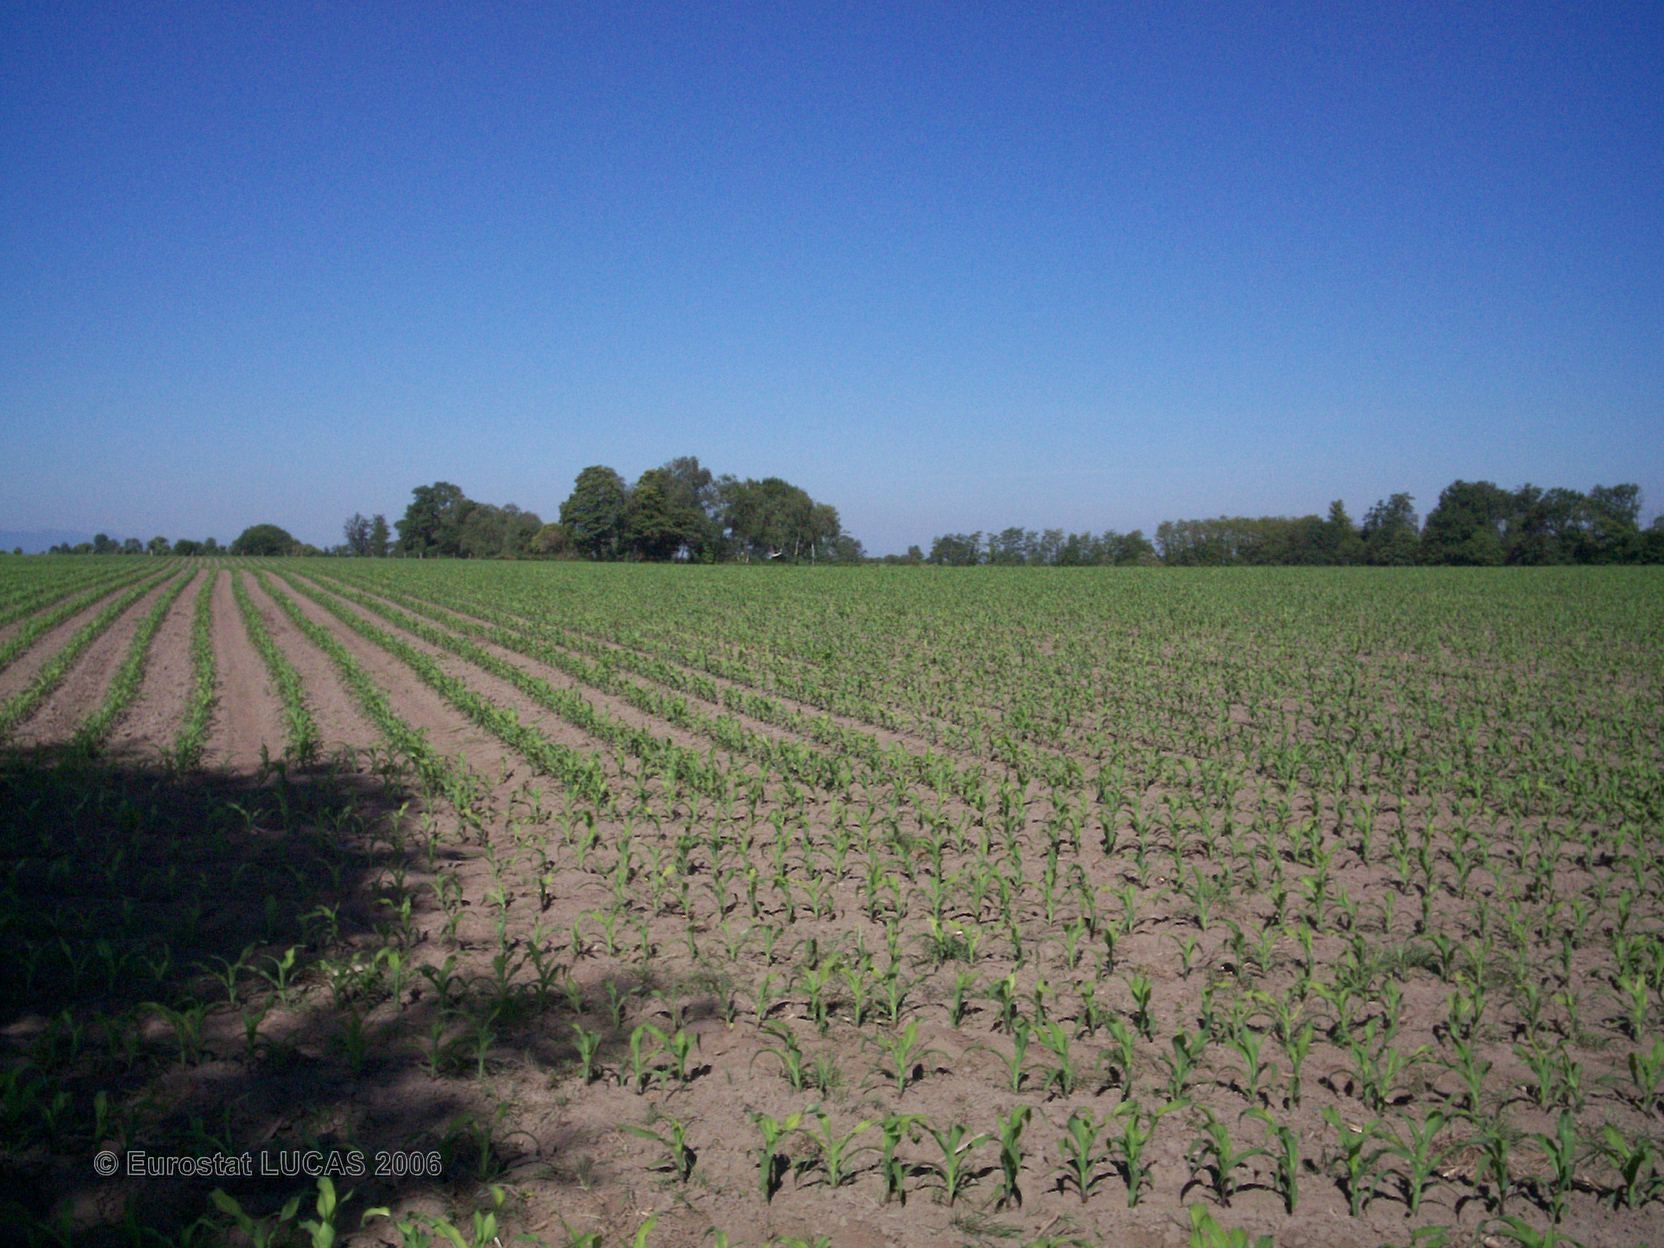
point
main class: Cropland
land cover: Maize
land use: Agriculture (excluding fallow land and kitchen gardens)
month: June
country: FR
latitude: 43.2528
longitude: -0.1419
